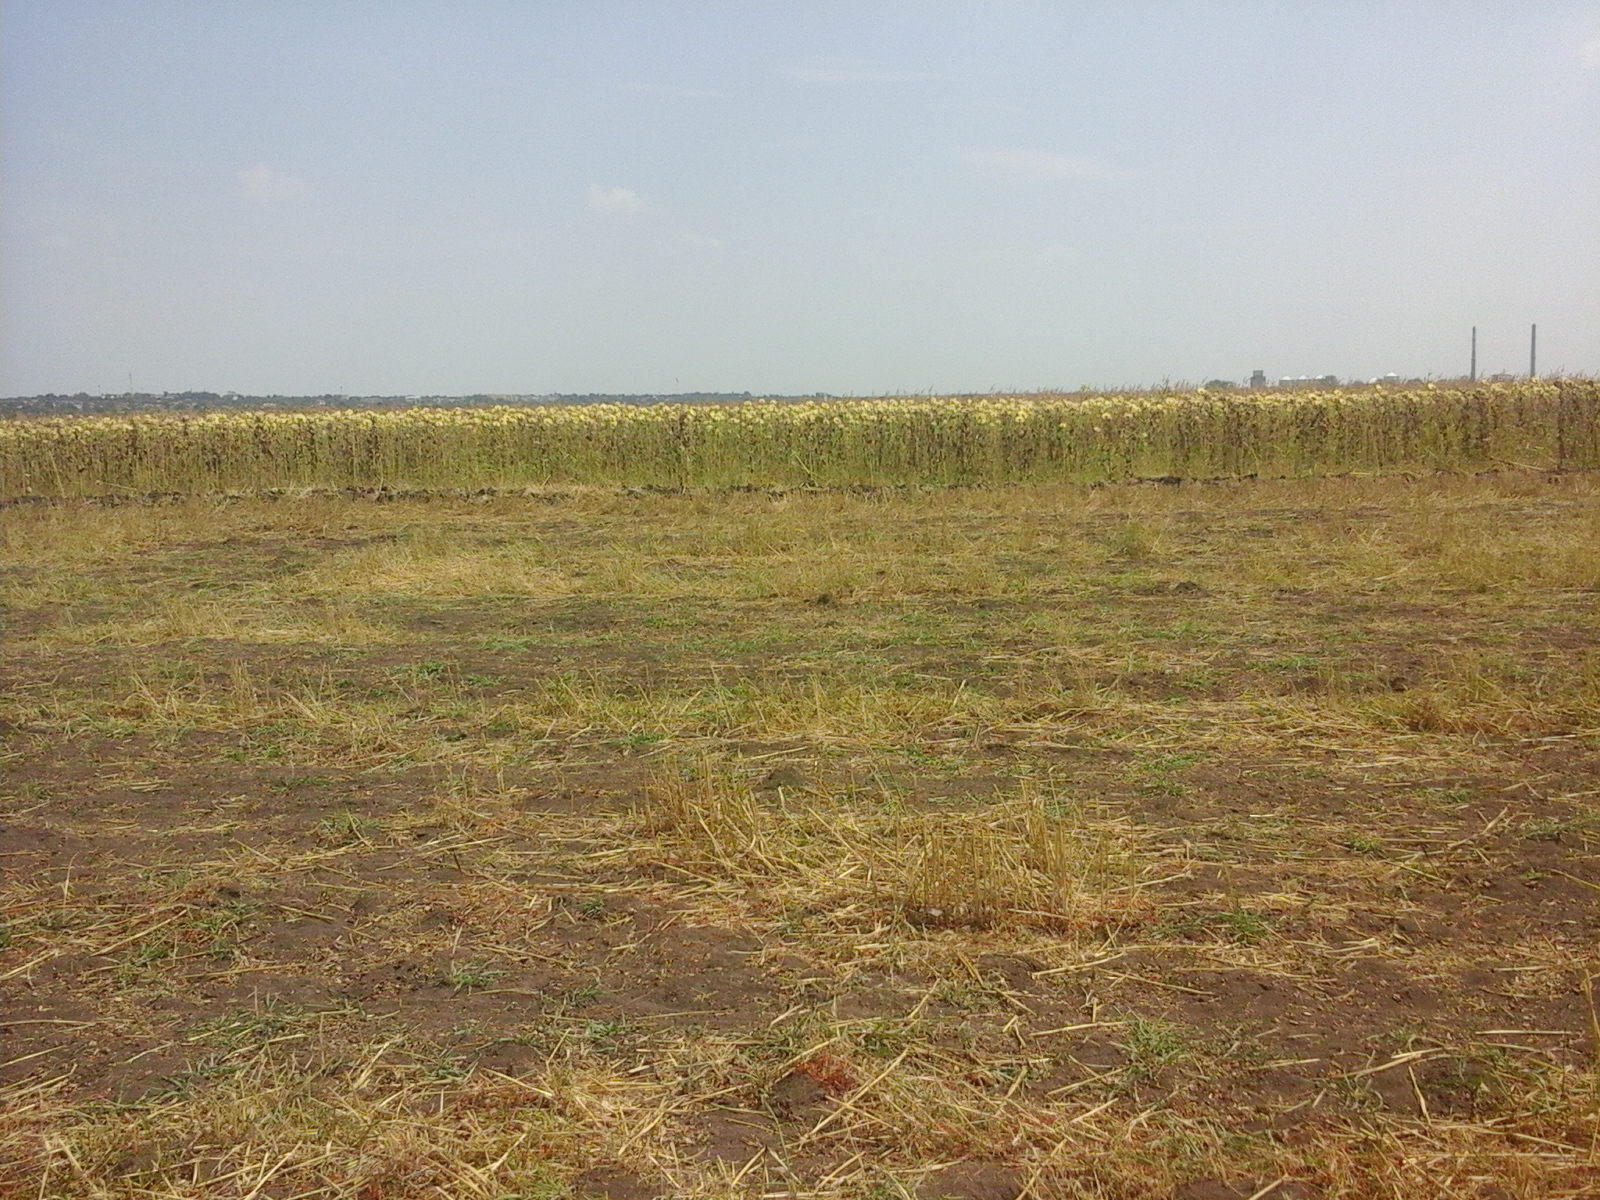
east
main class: Cropland
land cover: Common wheat
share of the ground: 25 - 50 %
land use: Agriculture (excluding fallow land and kitchen gardens)
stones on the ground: < 10 %
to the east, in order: Common wheat; Sunflower; Maize; Spontaneously vegetated surfaces; Maize
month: August
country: RO
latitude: 44.0941
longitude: 23.7055
